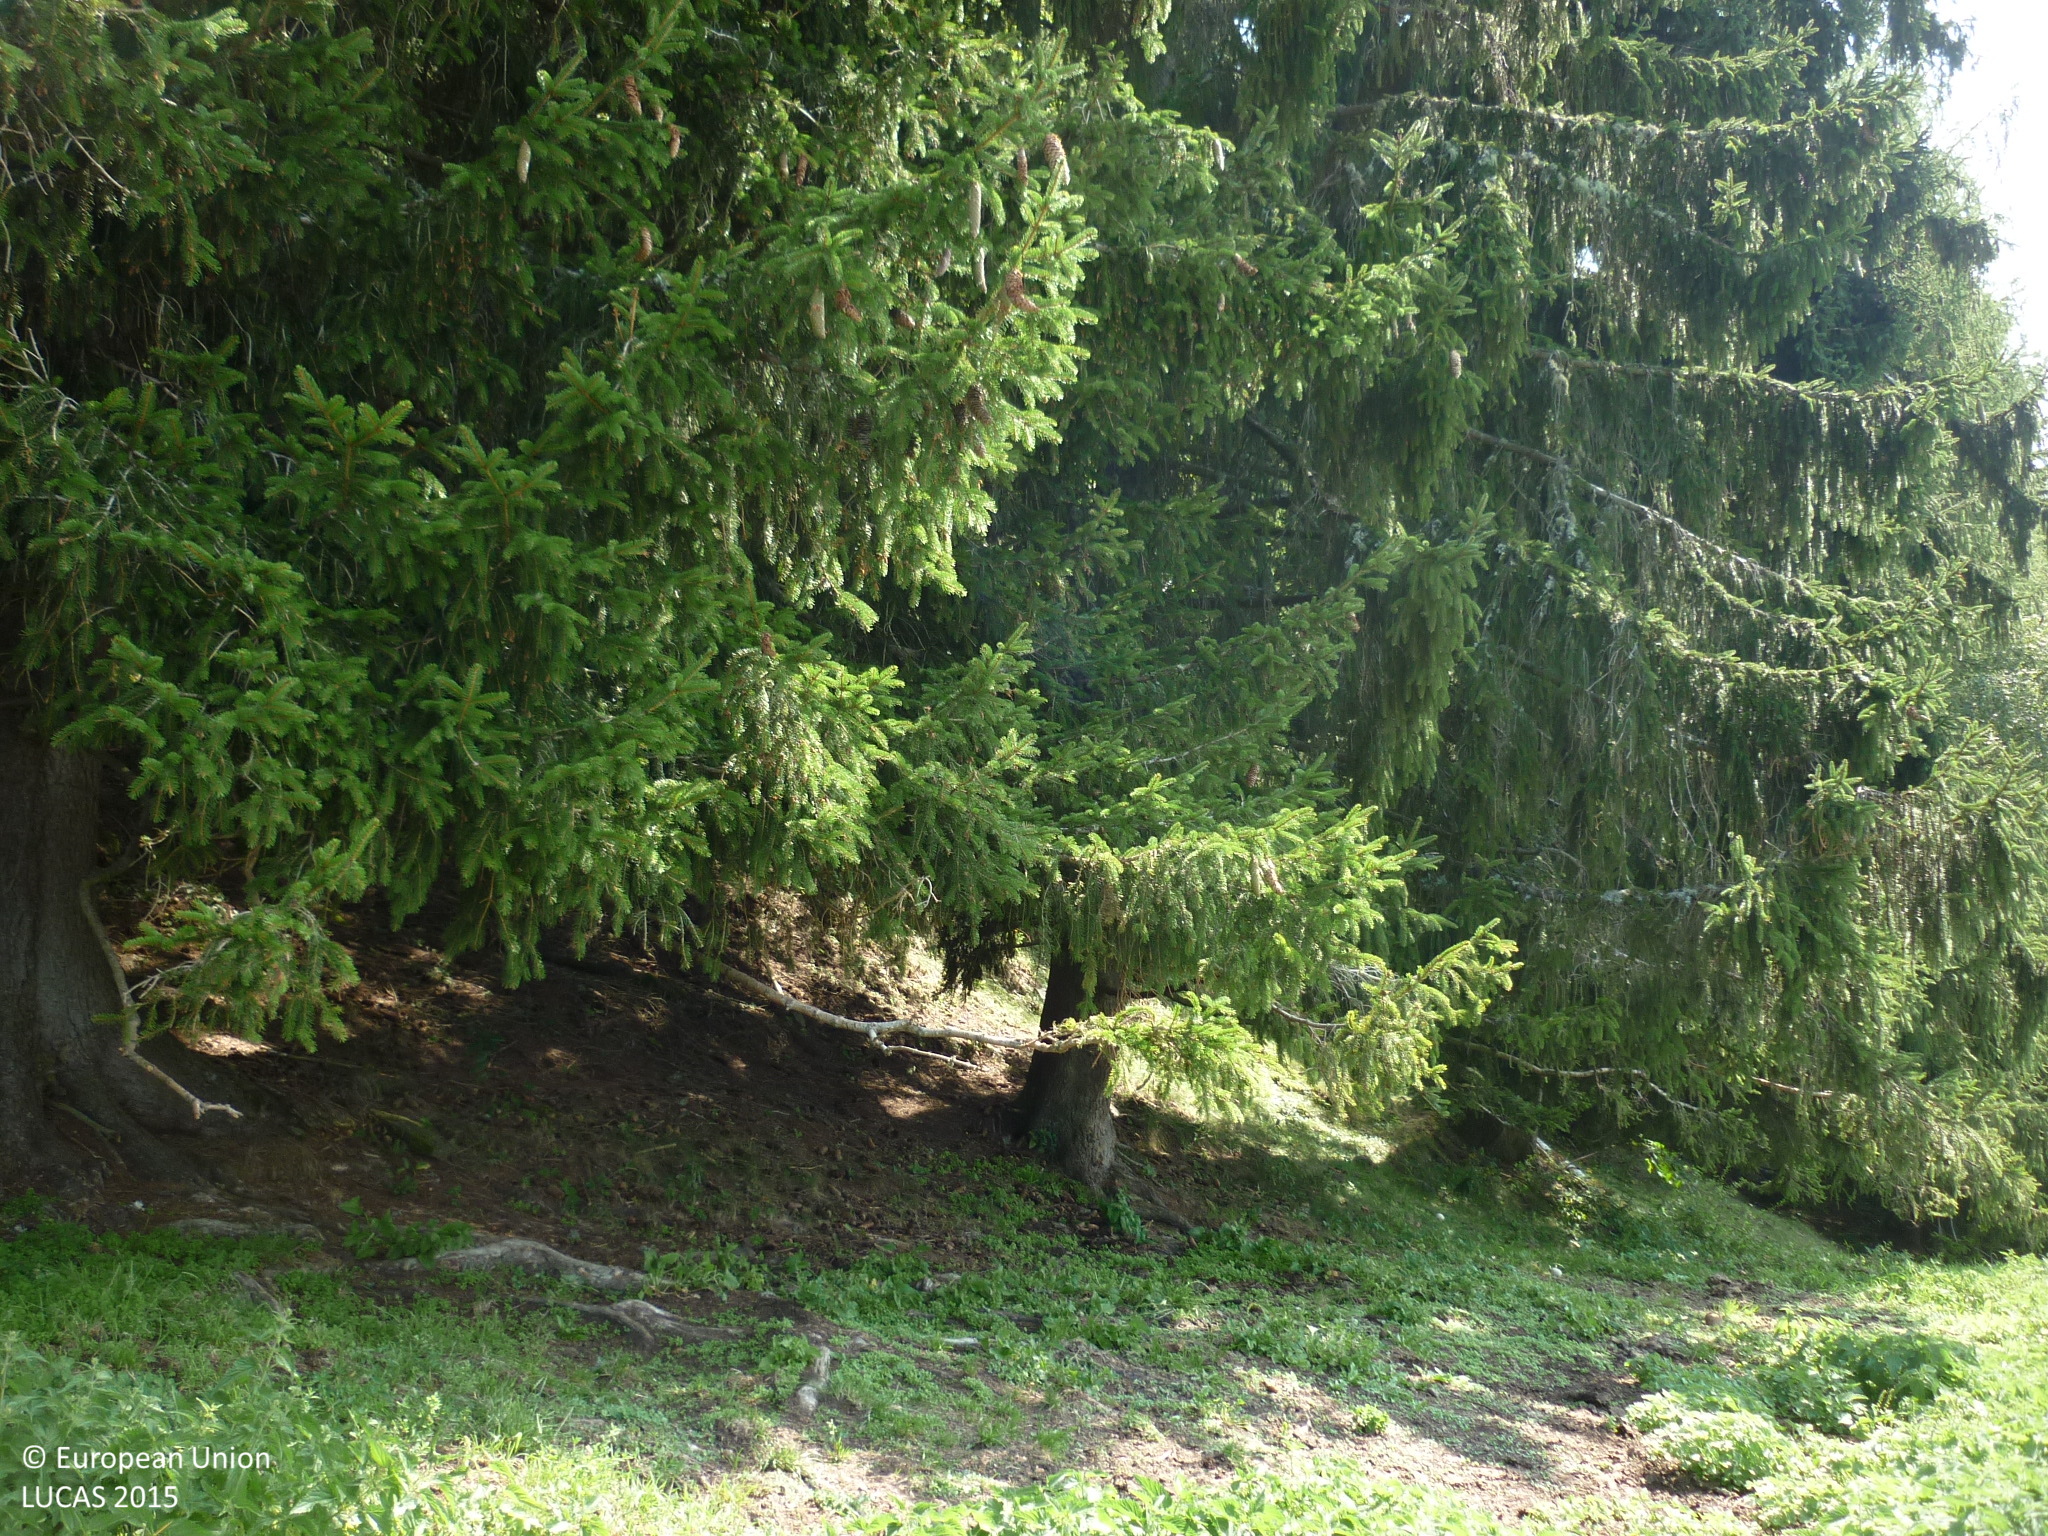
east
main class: Grassland
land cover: Grassland without tree/shrub cover
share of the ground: > 75 %
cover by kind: herbaceous plants 95 %, shrubs 5 %
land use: Agriculture (excluding fallow land and kitchen gardens)
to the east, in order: Grassland without tree/shrub cover; Spruce dominated coniferous woodland; Fences; Tracks; Spruce dominated coniferous woodland
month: August
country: AT
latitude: 46.9248
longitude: 14.4764
